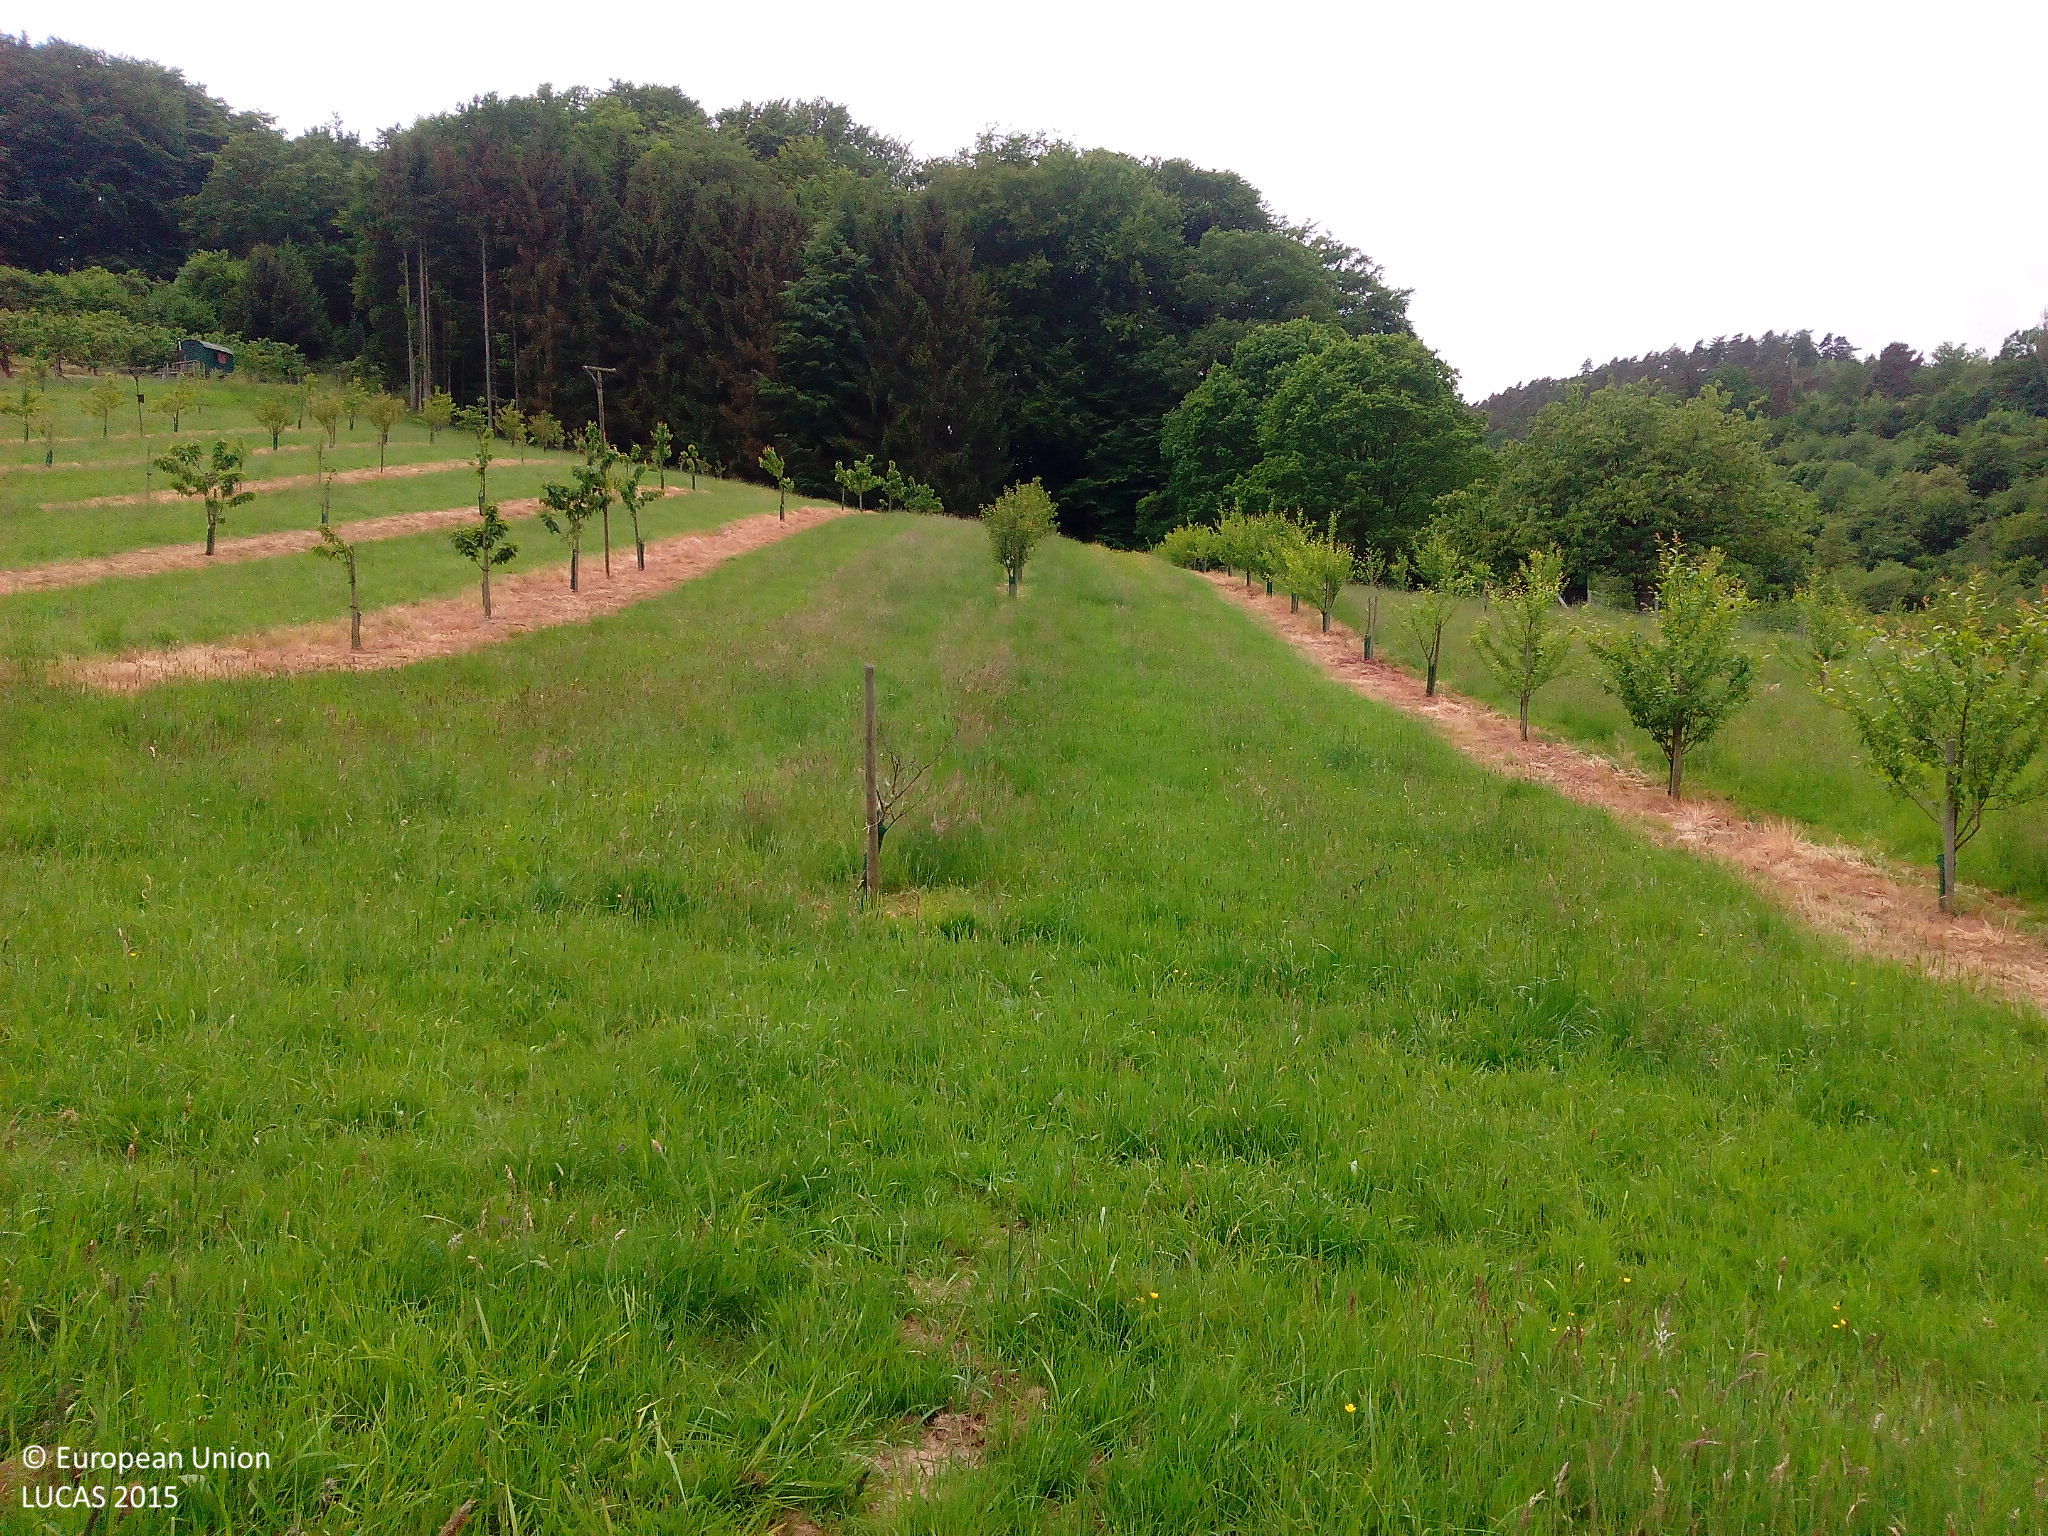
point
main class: Cropland
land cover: Cherry fruit
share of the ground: < 10 %
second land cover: Grassland without tree/shrub cover
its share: > 75 %
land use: Agriculture (excluding fallow land and kitchen gardens)
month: May
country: DE
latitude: 51.3169
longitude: 9.8709
